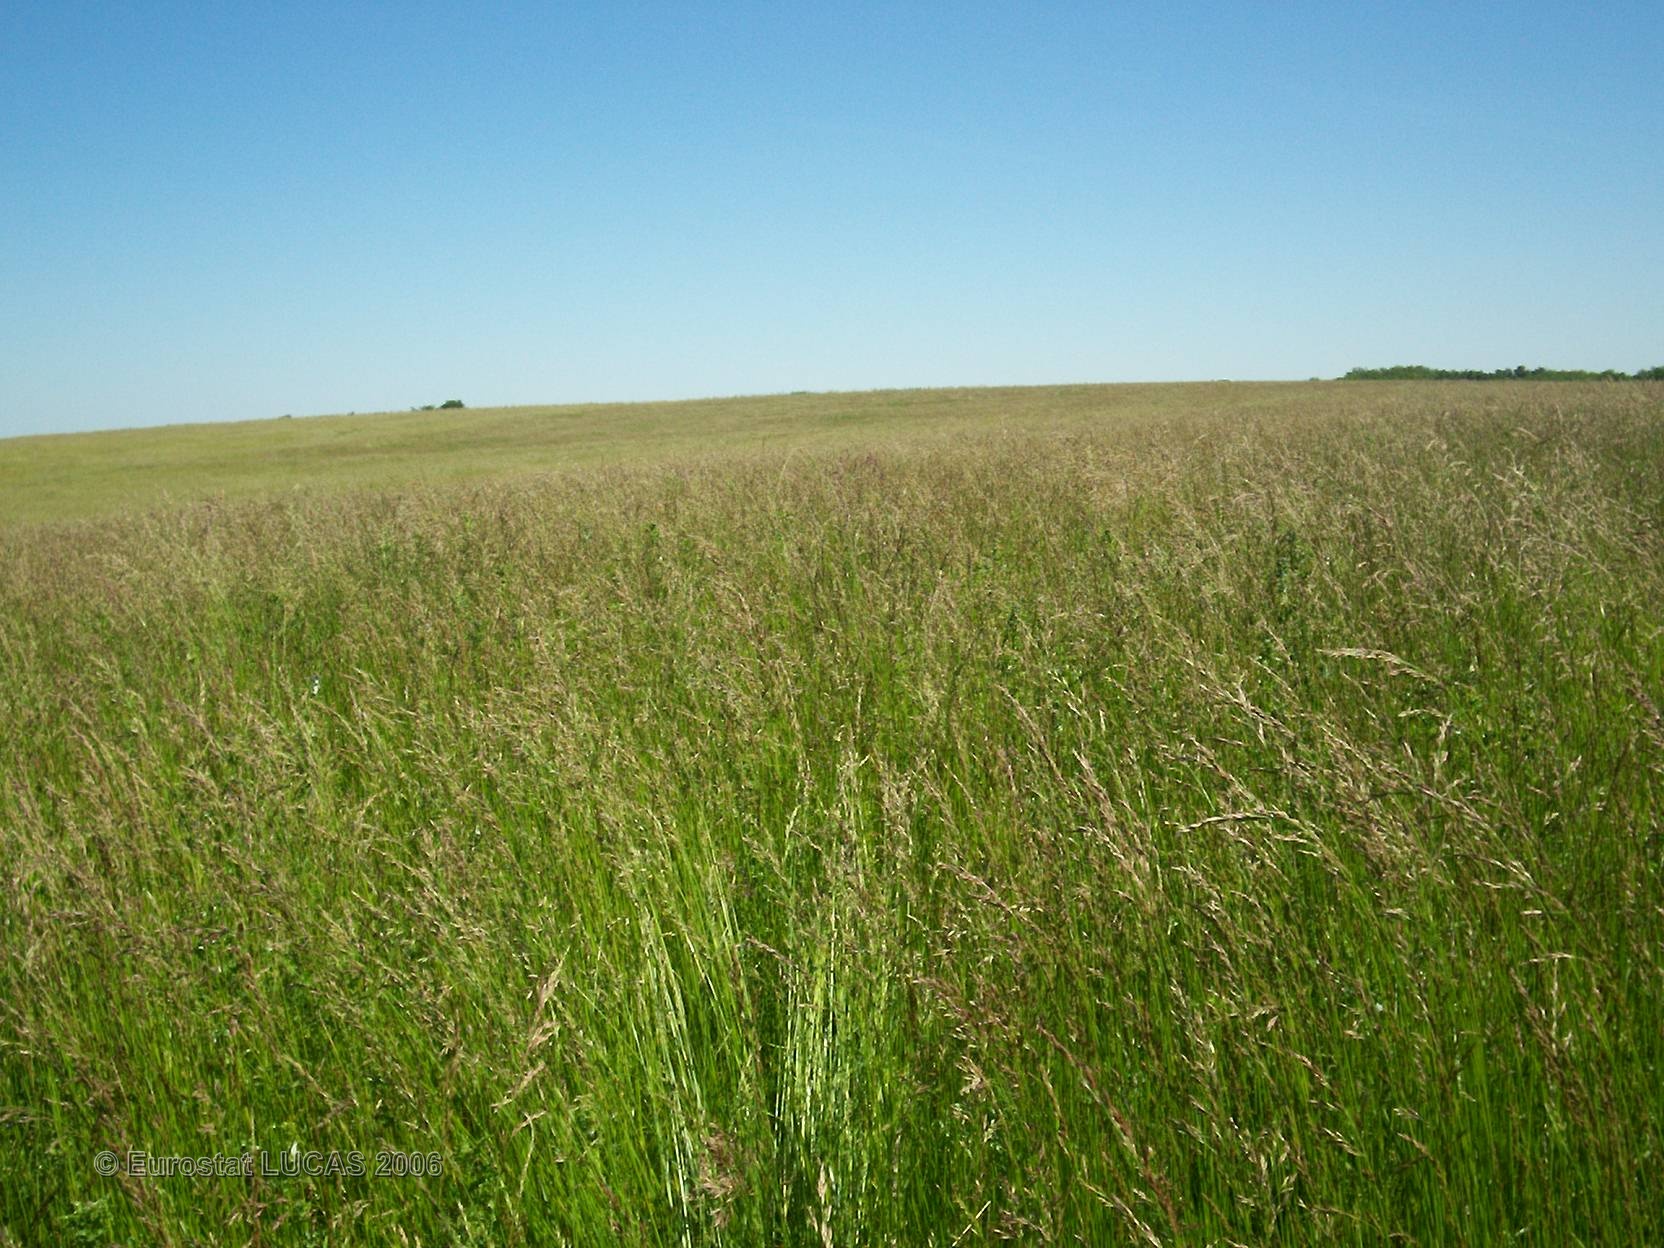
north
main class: Grassland
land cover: Grassland without tree/shrub cover
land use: Agriculture (excluding fallow land and kitchen gardens)
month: June
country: FR
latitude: 48.5802
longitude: 4.6432
